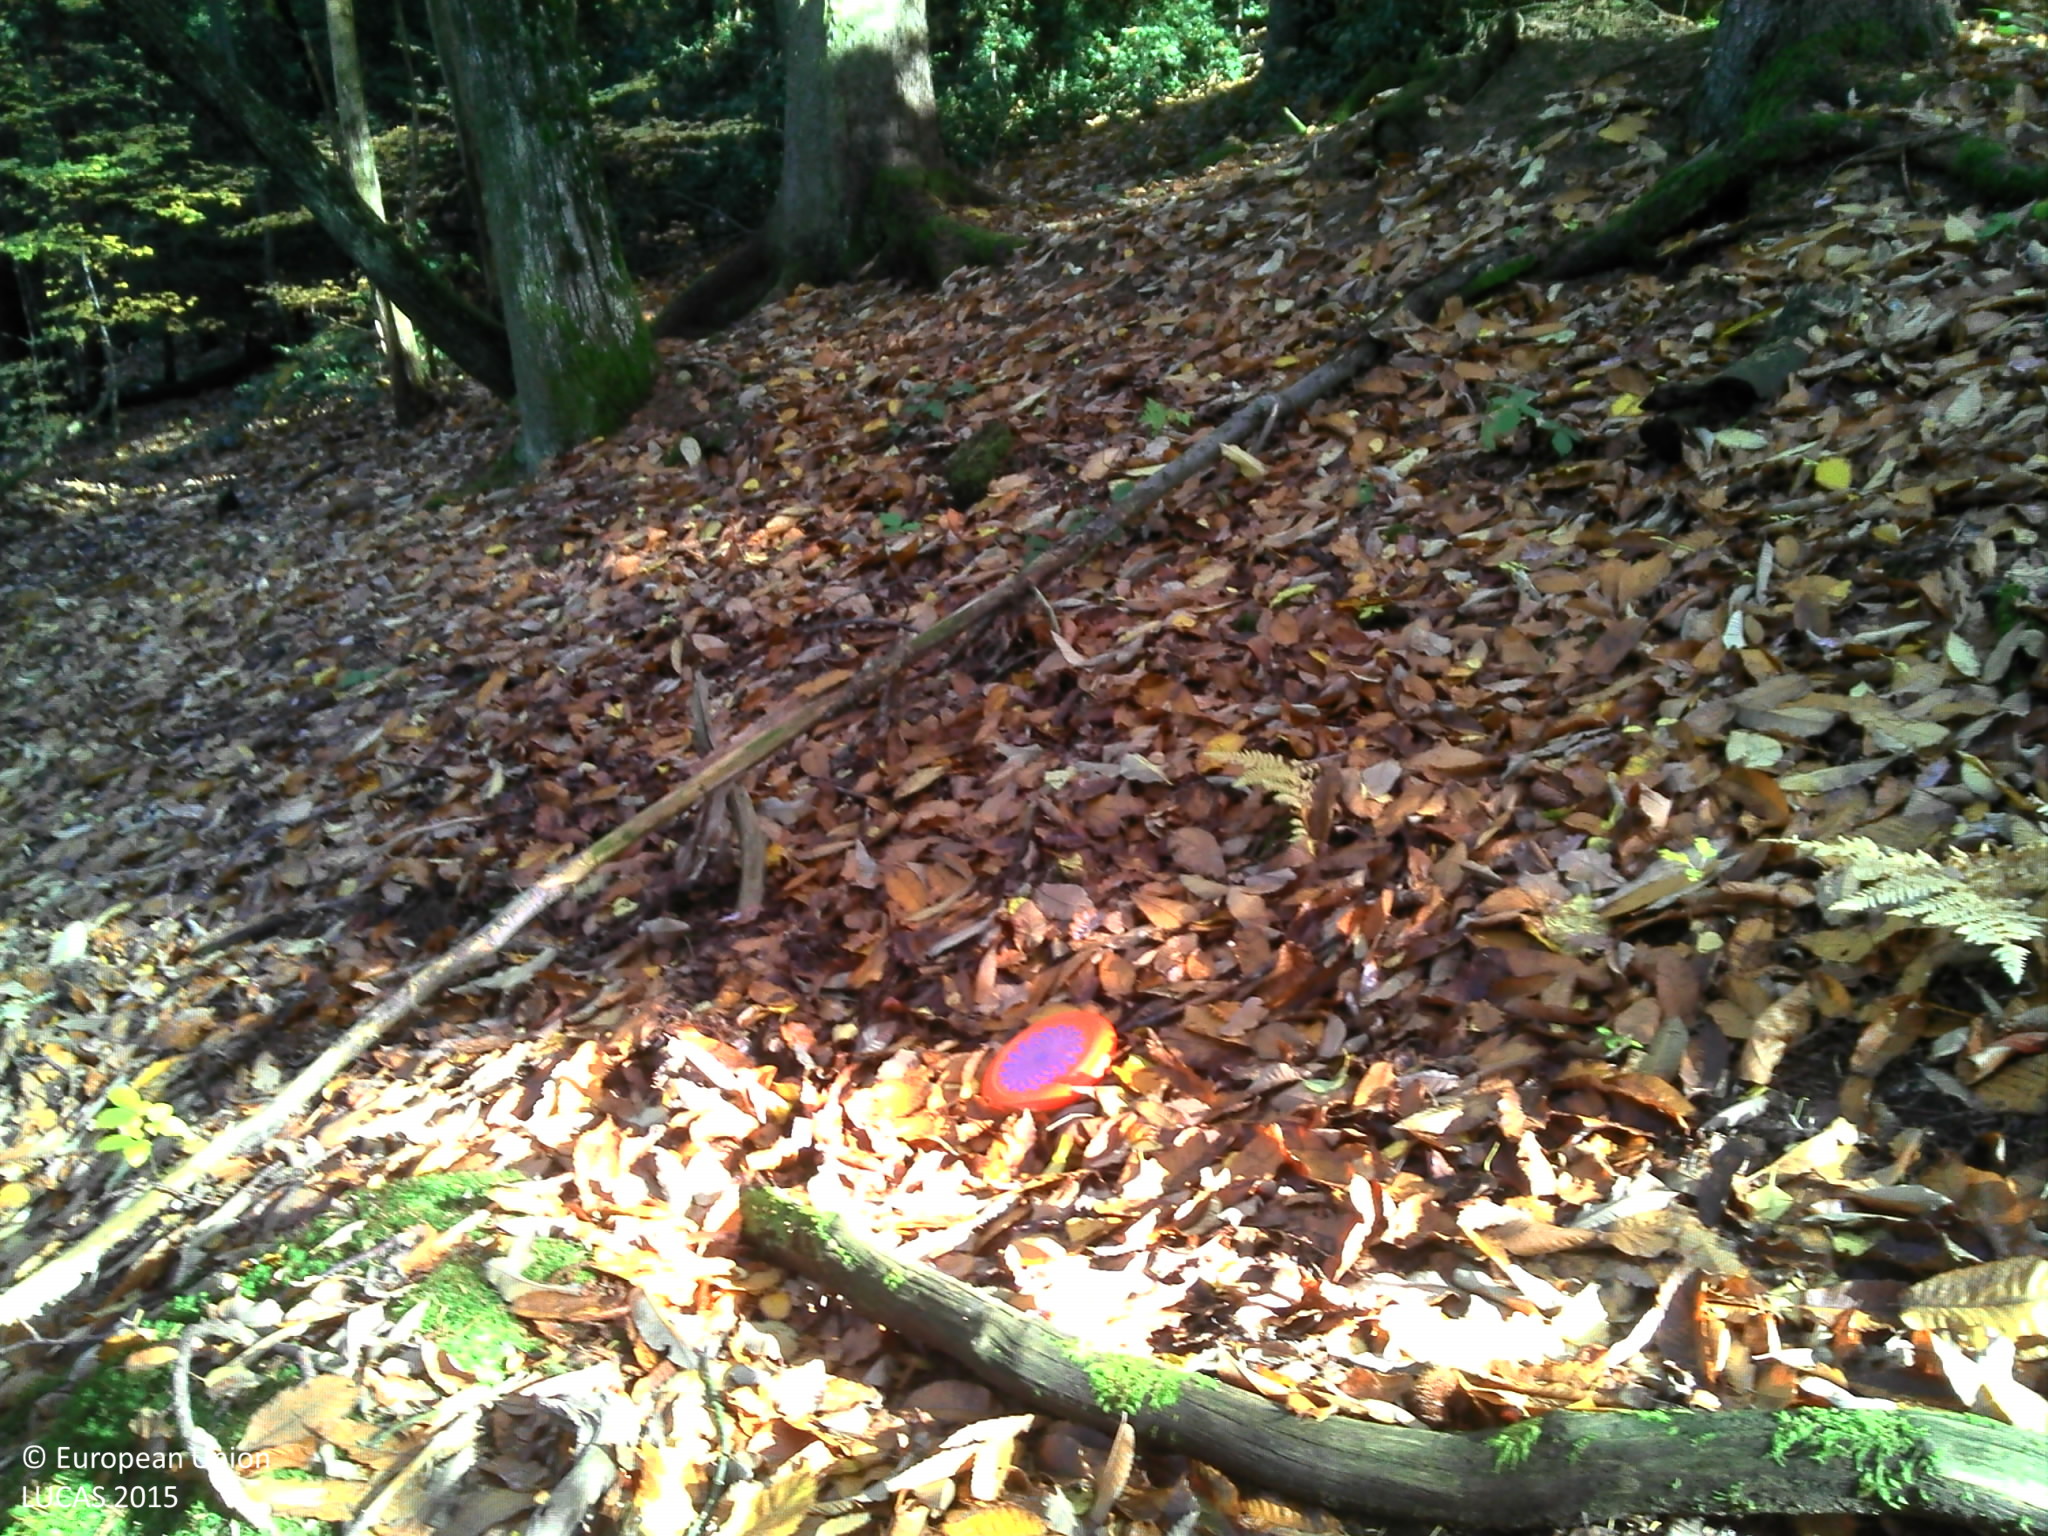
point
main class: Woodland
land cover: Spruce dominated mixed woodland
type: hemiboreal forest and nemoral coniferous forest and mixed broadleaved-coniferous forest
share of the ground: > 75 %
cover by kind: coniferous forest trees 45 %, broadleaved forest trees 45 %, unconsolidated bare surface 10 %
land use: Forestry
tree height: > 5 m
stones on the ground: < 10 %
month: October
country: FR
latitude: 45.4705
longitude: 6.1547
